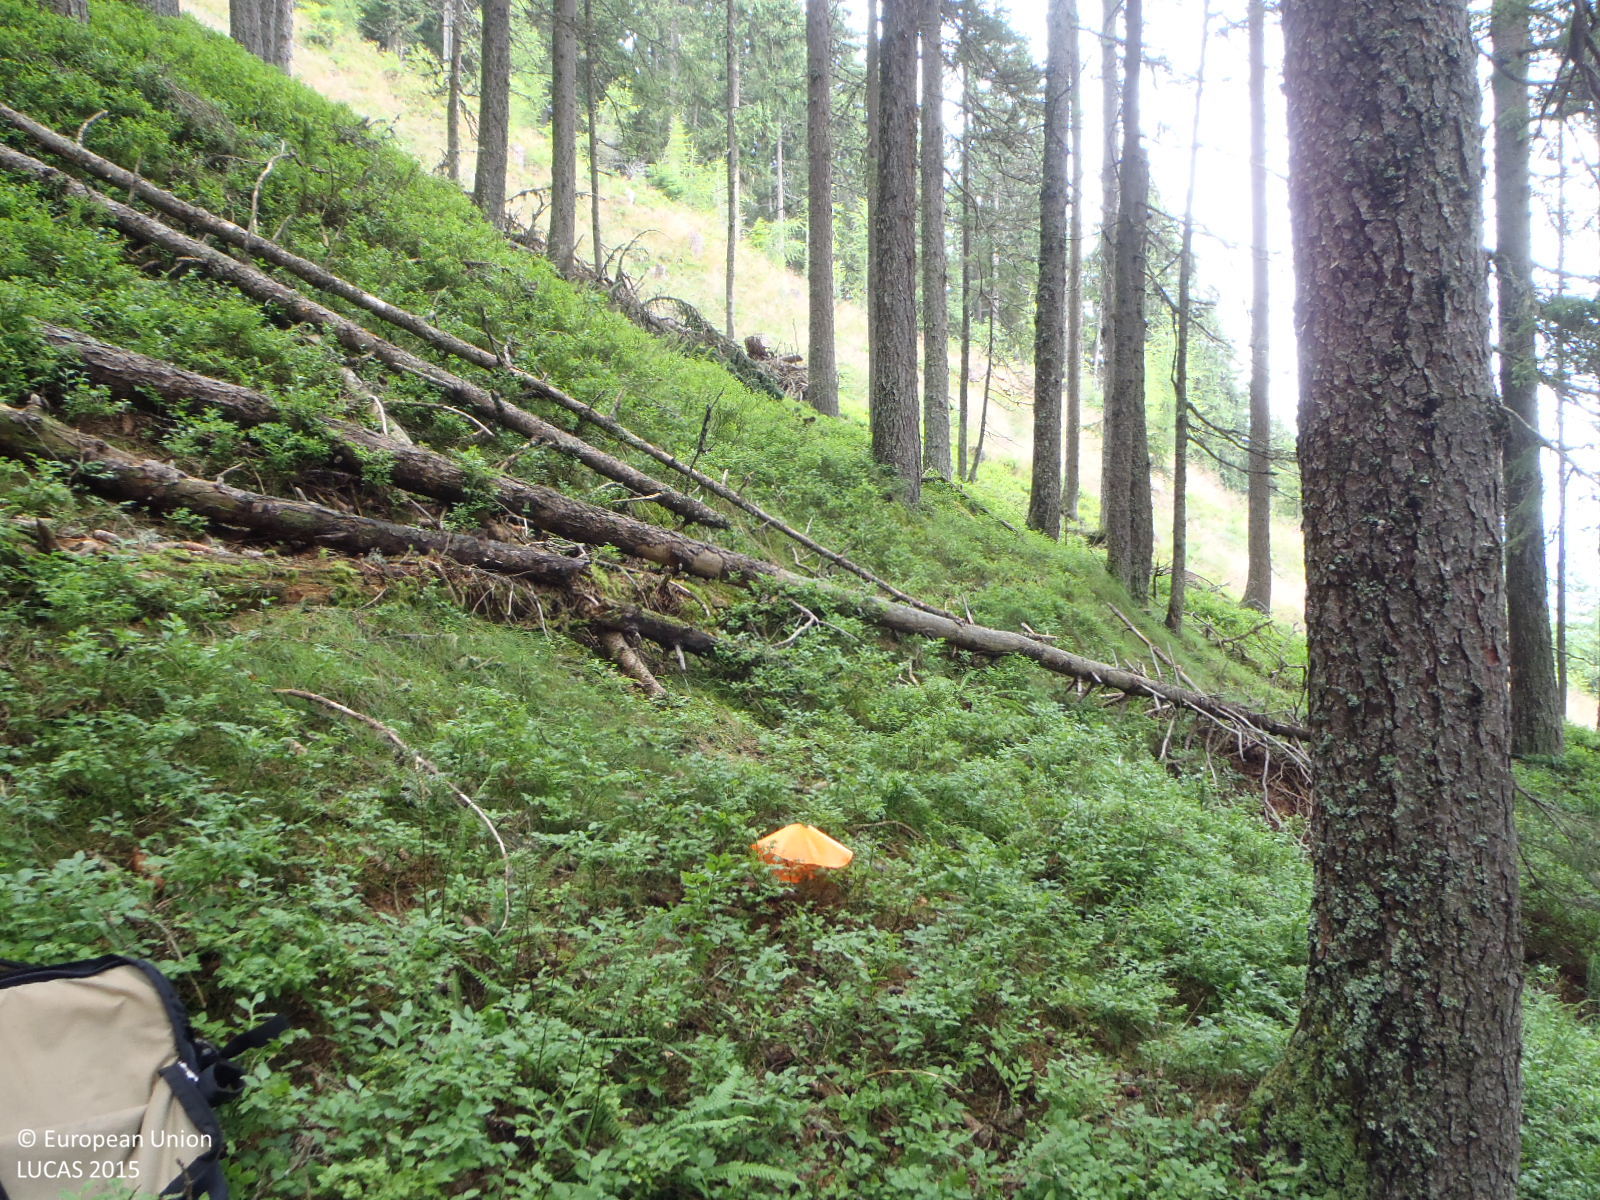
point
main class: Woodland
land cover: Spruce dominated coniferous woodland
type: alpine coniferous forest
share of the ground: > 75 %
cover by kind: coniferous forest trees 90 %, shrubs 10 %
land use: Forestry
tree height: > 5 m
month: July
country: AT
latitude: 47.3445
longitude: 11.8119
